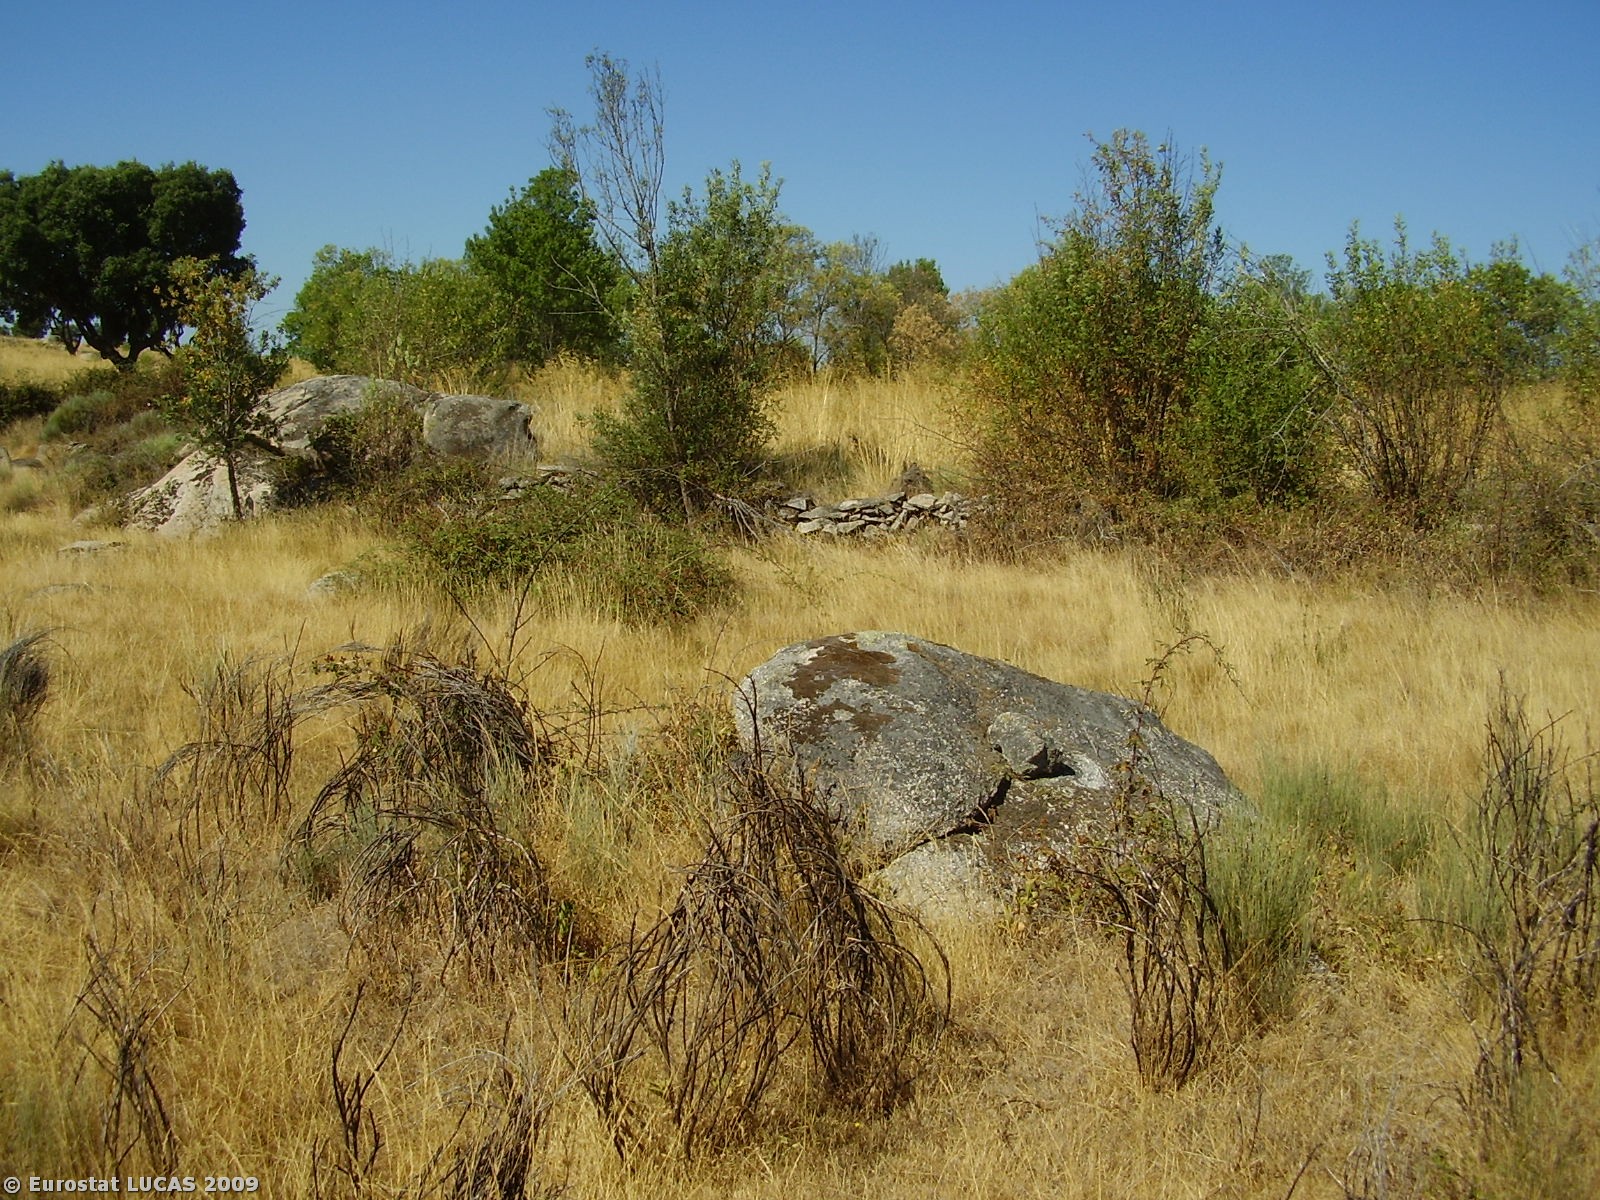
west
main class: Grassland
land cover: Spontaneously vegetated surfaces
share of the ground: > 75 %
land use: Fallow land
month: August
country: PT
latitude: 41.2376
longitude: -6.7001
